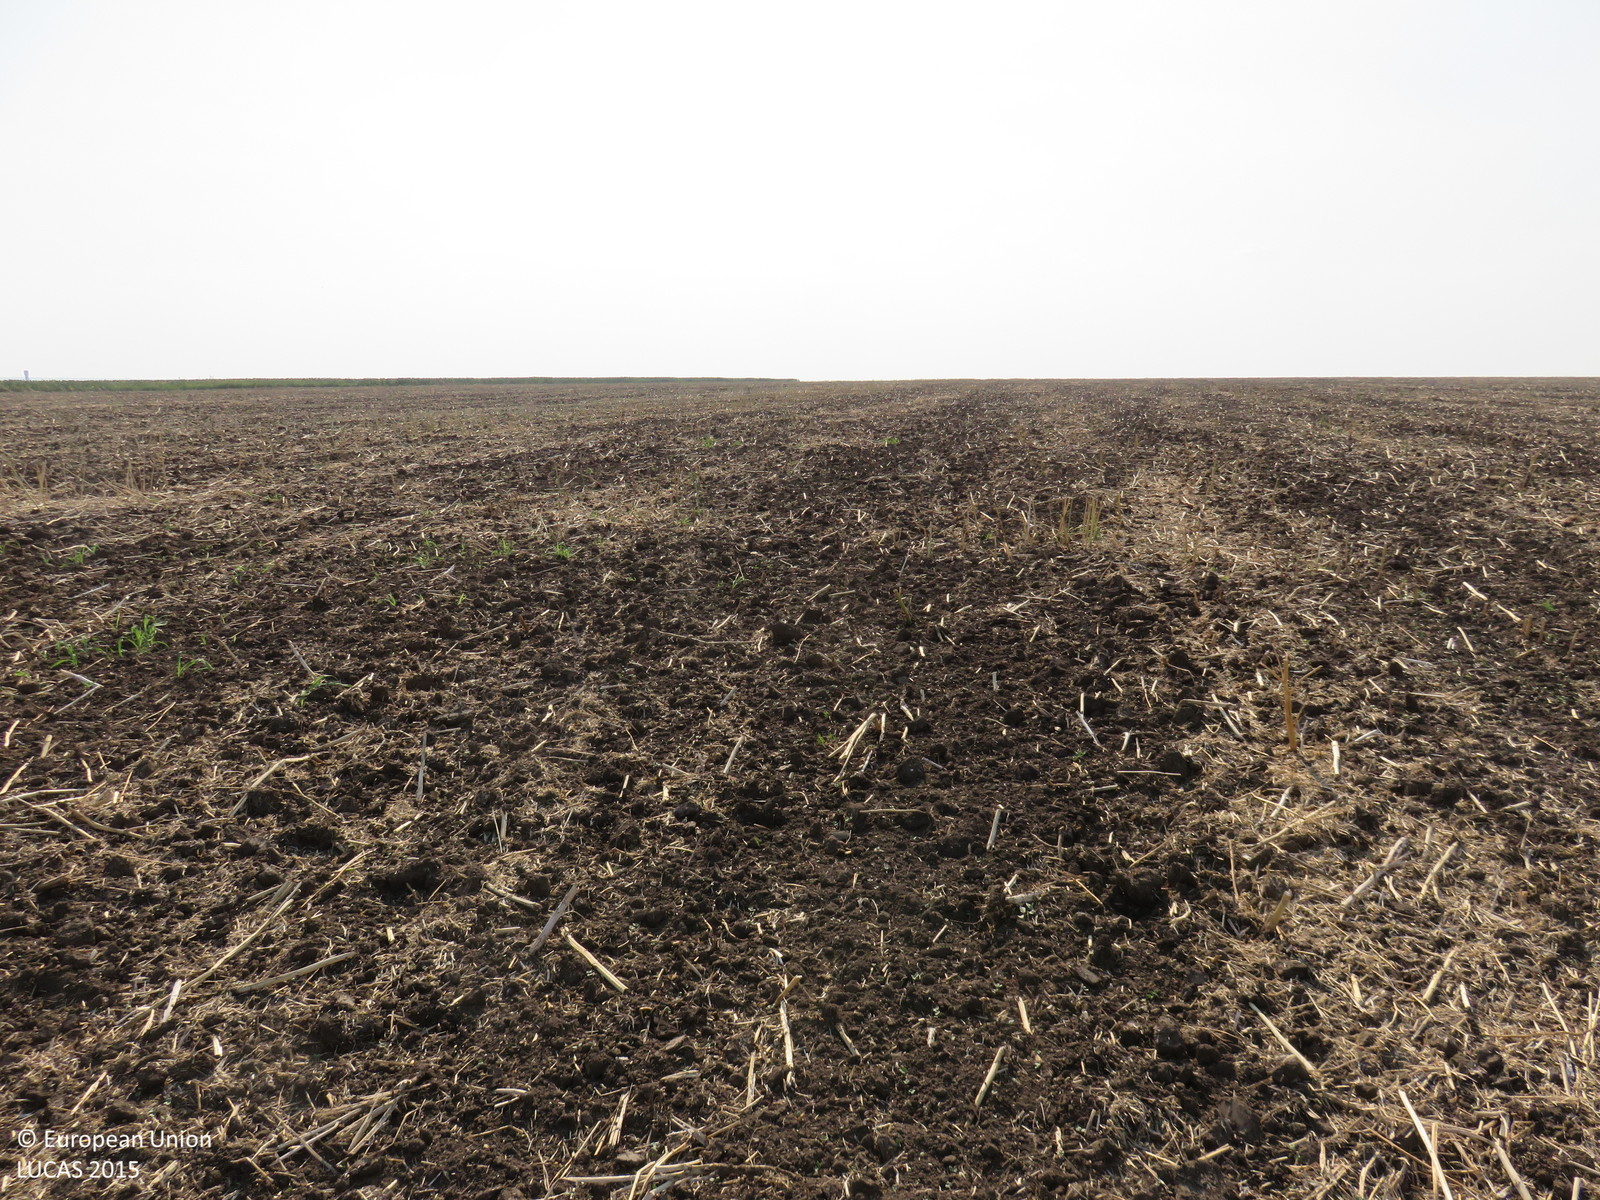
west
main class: Cropland
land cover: Rape and turnip rape
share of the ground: < 10 %
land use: Agriculture (excluding fallow land and kitchen gardens)
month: July
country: BG
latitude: 43.5059
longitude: 24.8993
